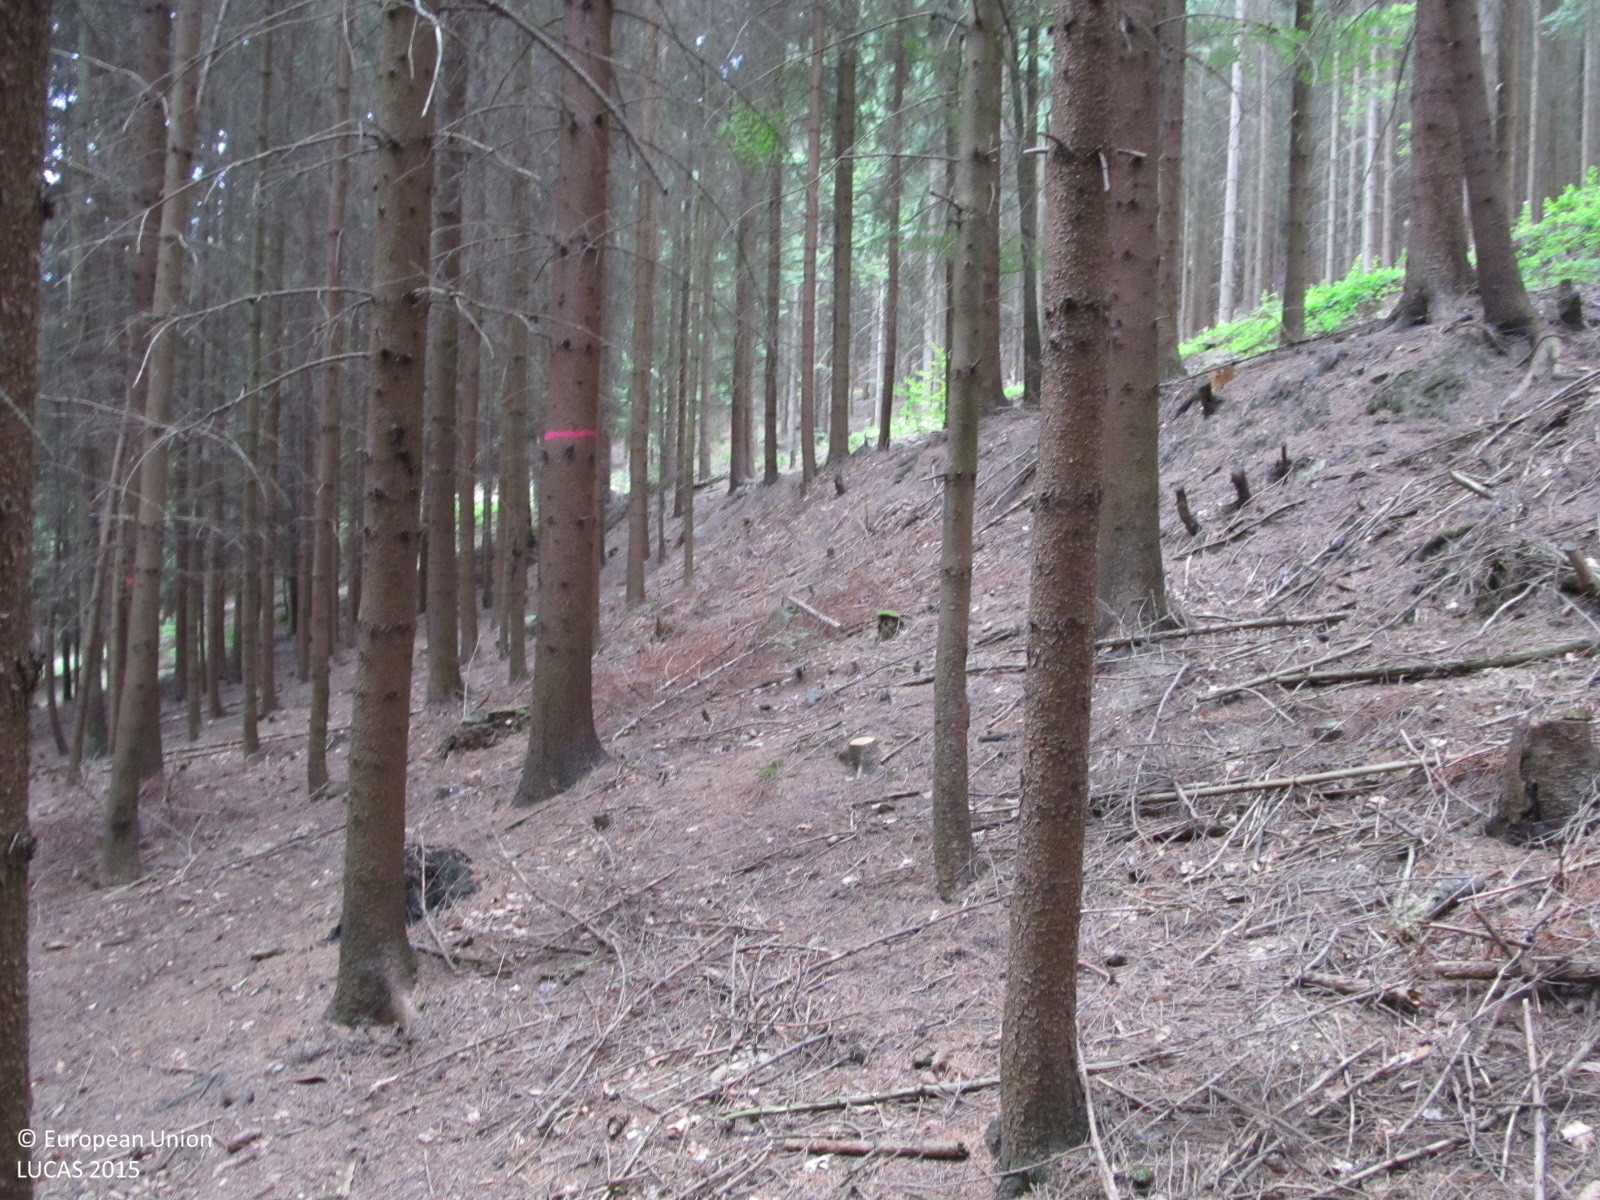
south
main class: Woodland
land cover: Spruce dominated coniferous woodland
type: hemiboreal forest and nemoral coniferous forest and mixed broadleaved-coniferous forest
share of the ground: > 75 %
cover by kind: coniferous forest trees 90 %, unconsolidated bare surface 10 %
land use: Forestry
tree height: > 5 m
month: September
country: AT
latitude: 48.3304
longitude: 15.3031
